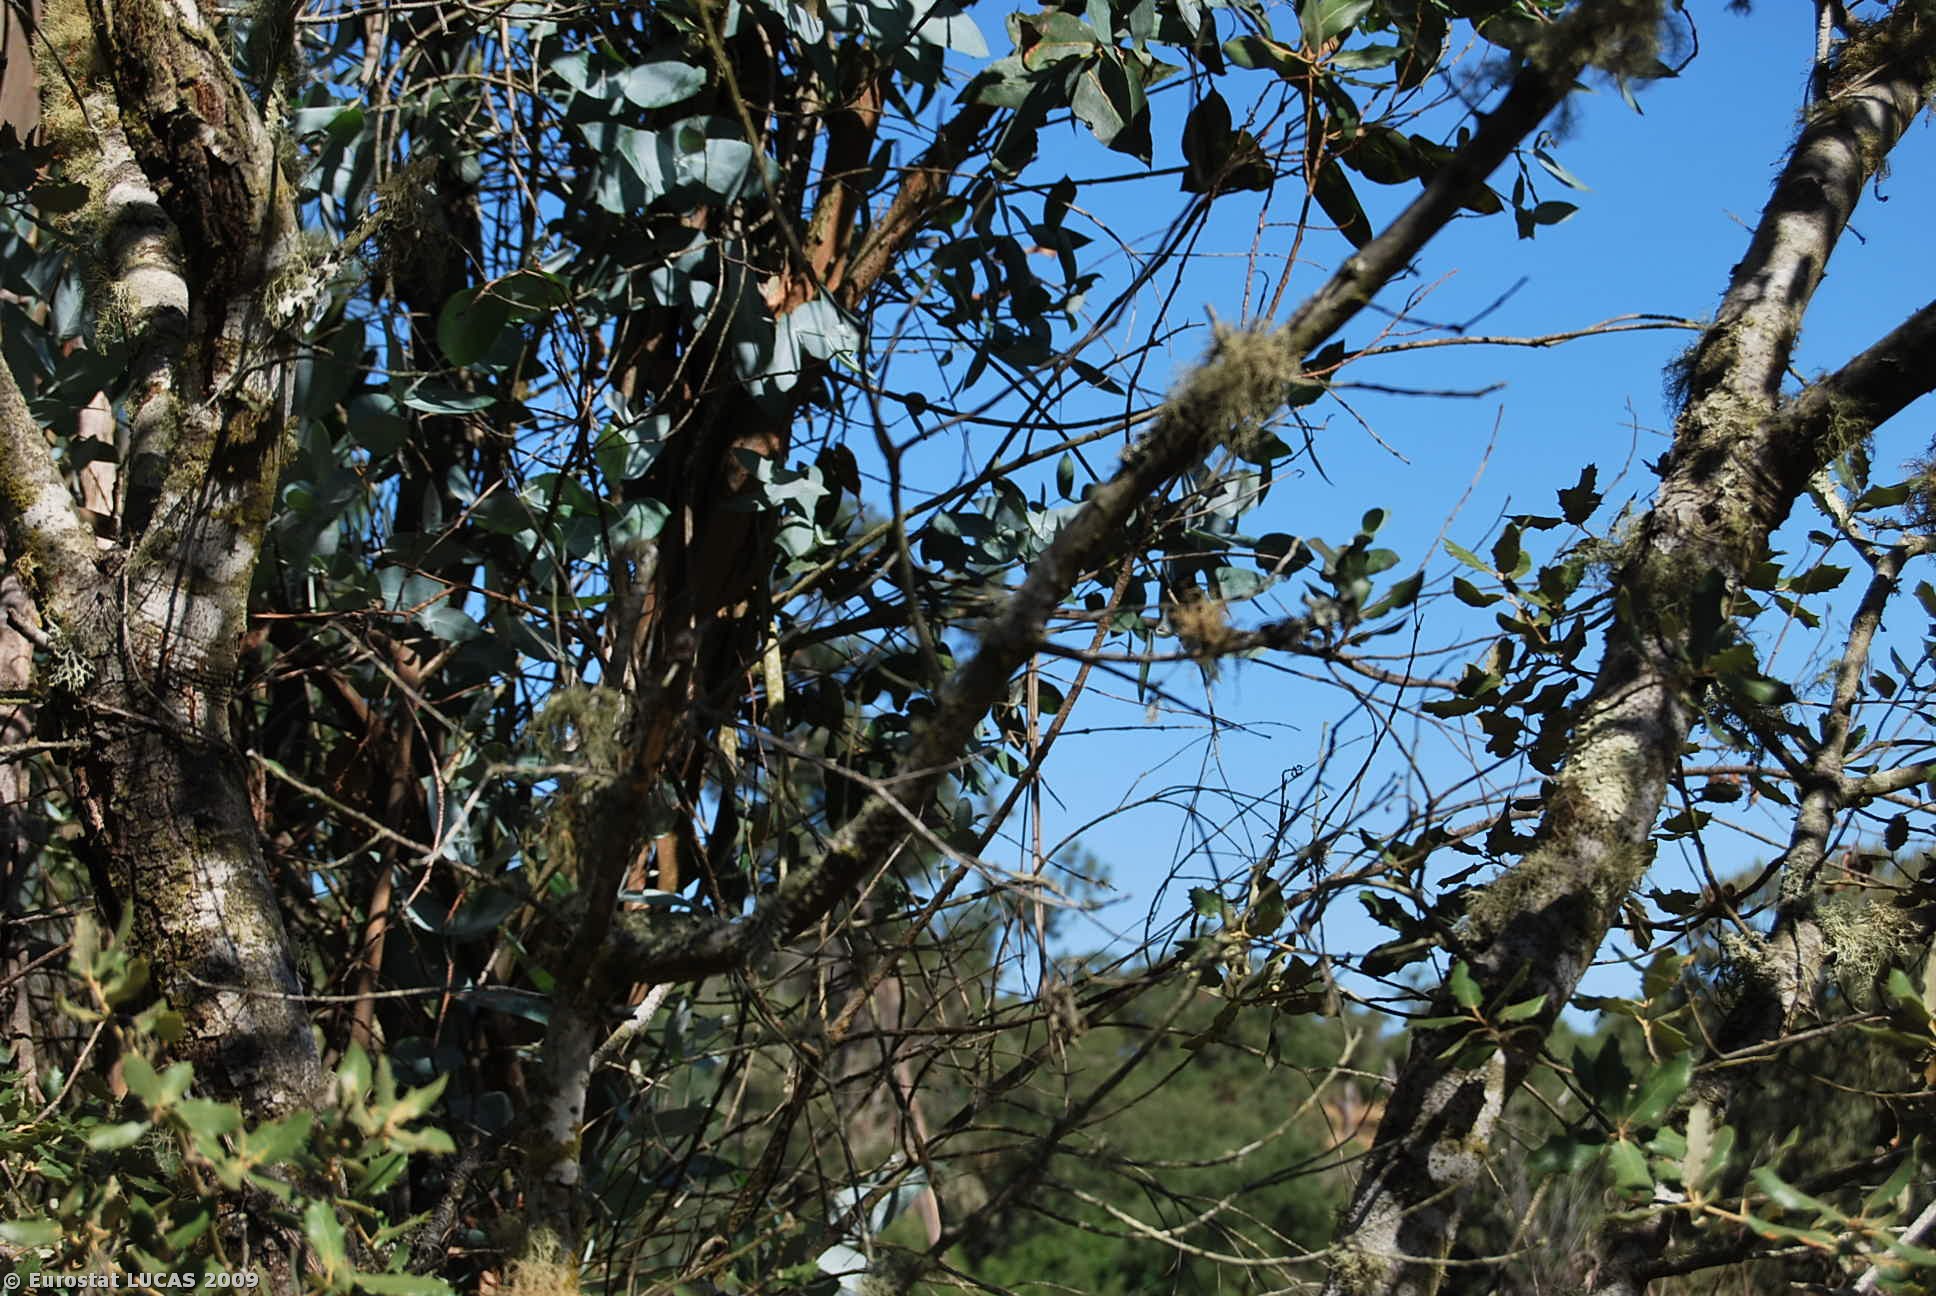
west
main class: Woodland
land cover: Broadleaved woodland
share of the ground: 25 - 50 %
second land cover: Shrubland with sparse tree cover
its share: 50 - 75 %
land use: Unused
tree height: < 5 m
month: June
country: PT
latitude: 37.9599
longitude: -8.5619
